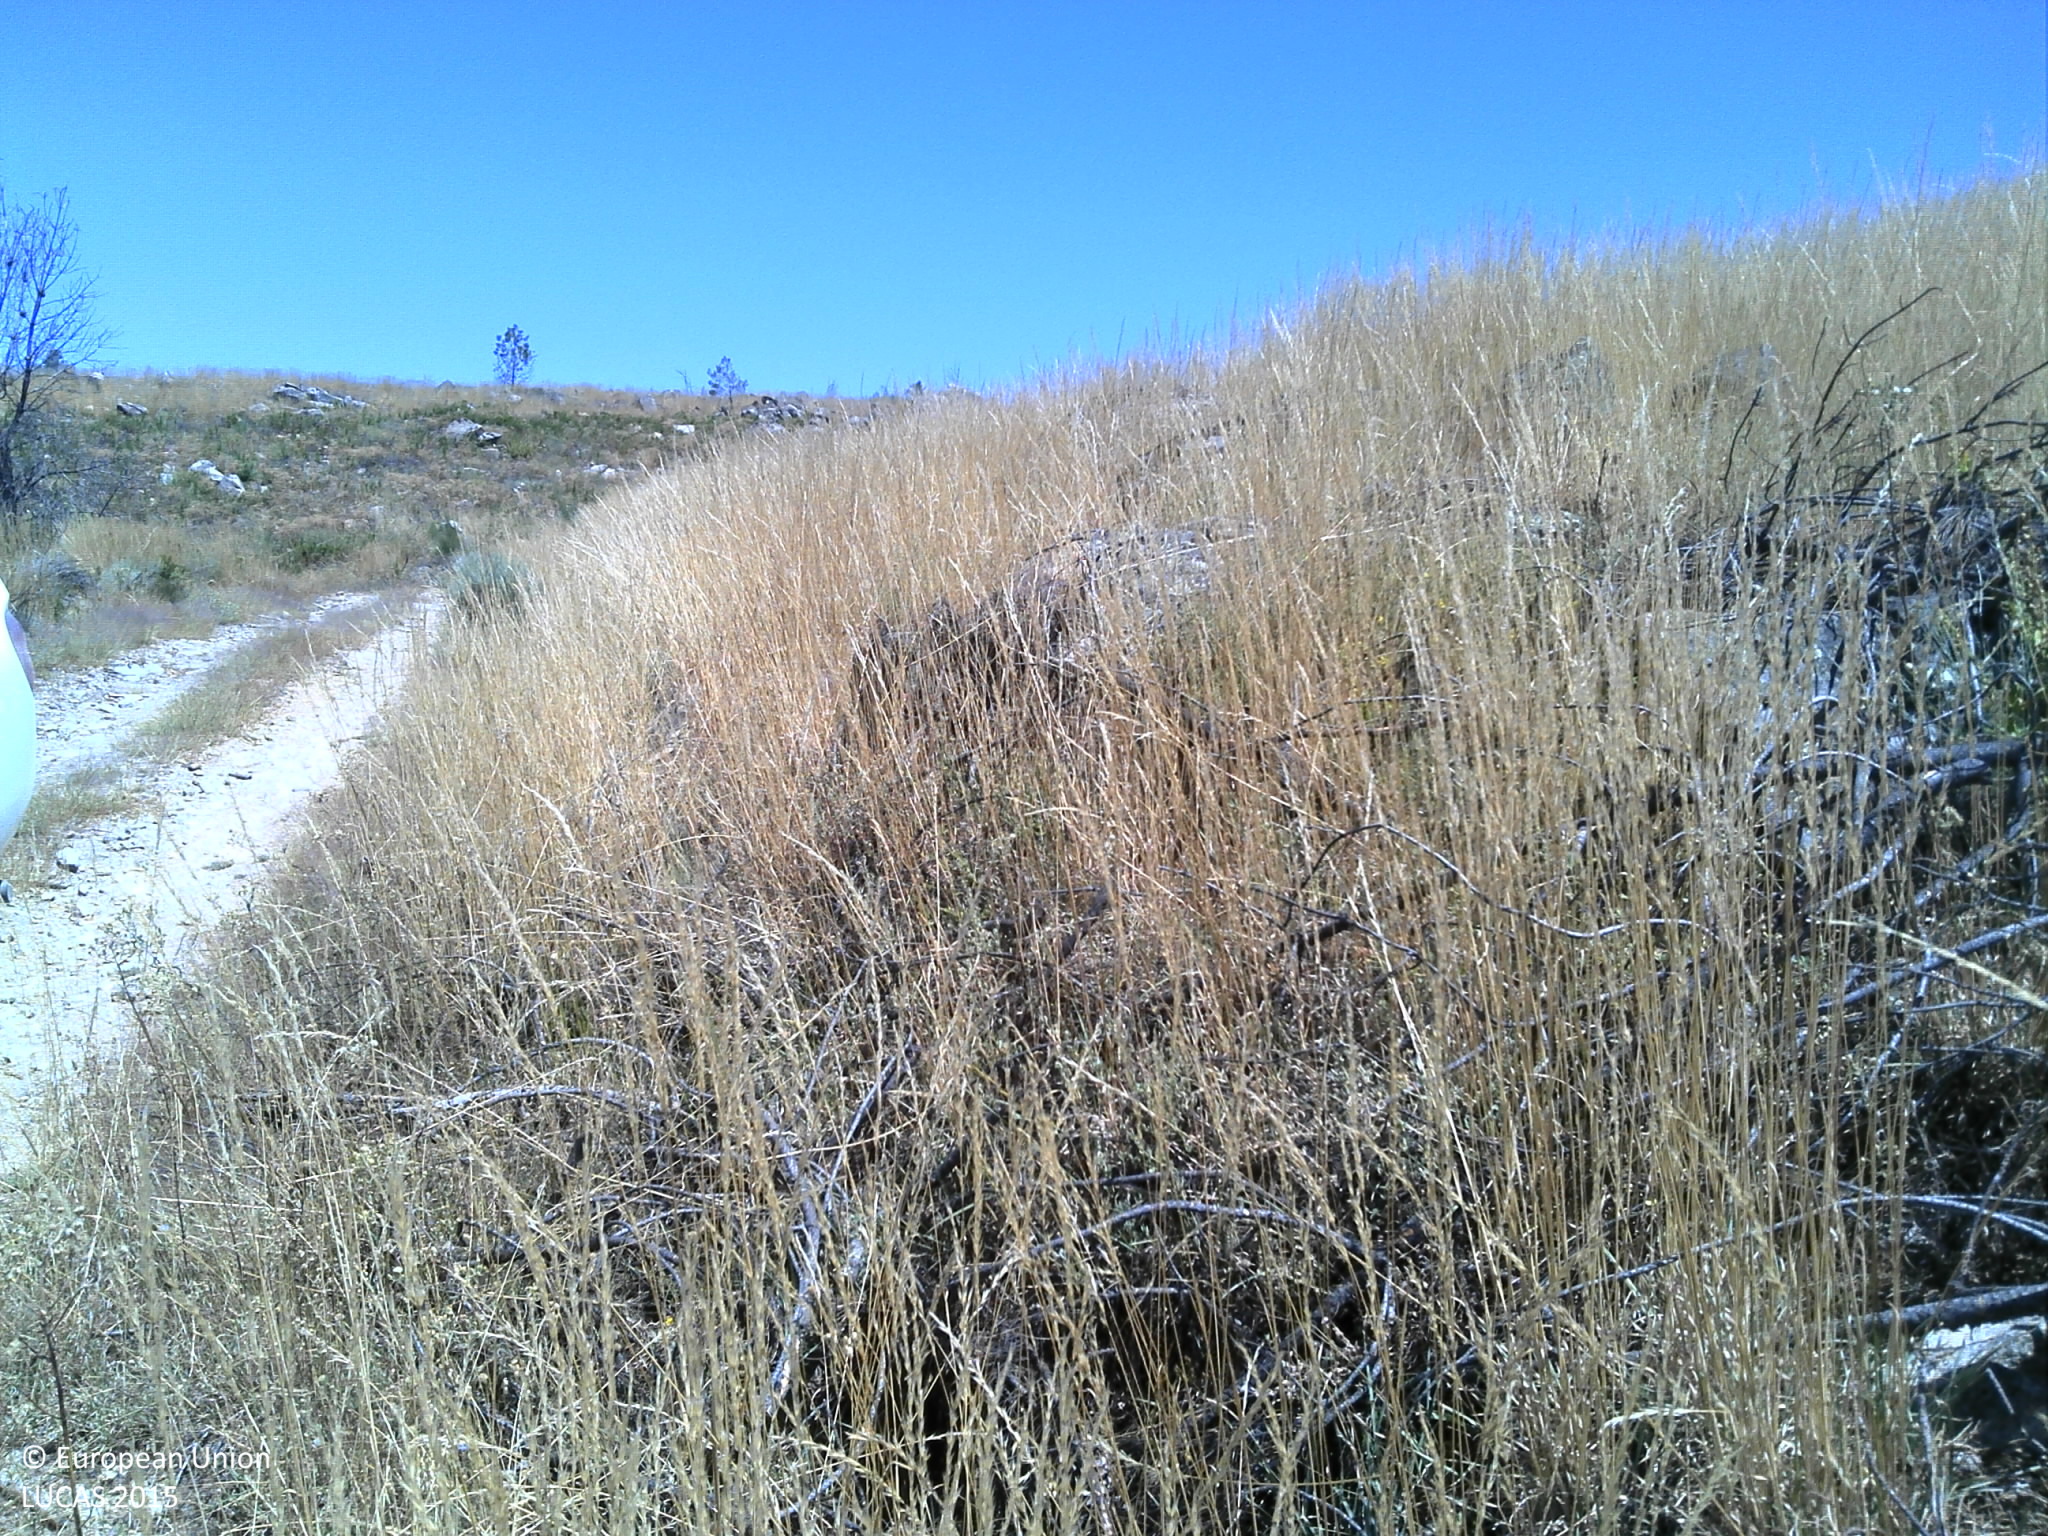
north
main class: Grassland
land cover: Spontaneously vegetated surfaces
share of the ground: > 75 %
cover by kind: herbaceous plants 95 %, unconsolidated bare surface 5 %
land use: Abandoned areas
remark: Burnt area
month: June
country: PT
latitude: 40.7298
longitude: -7.2898
